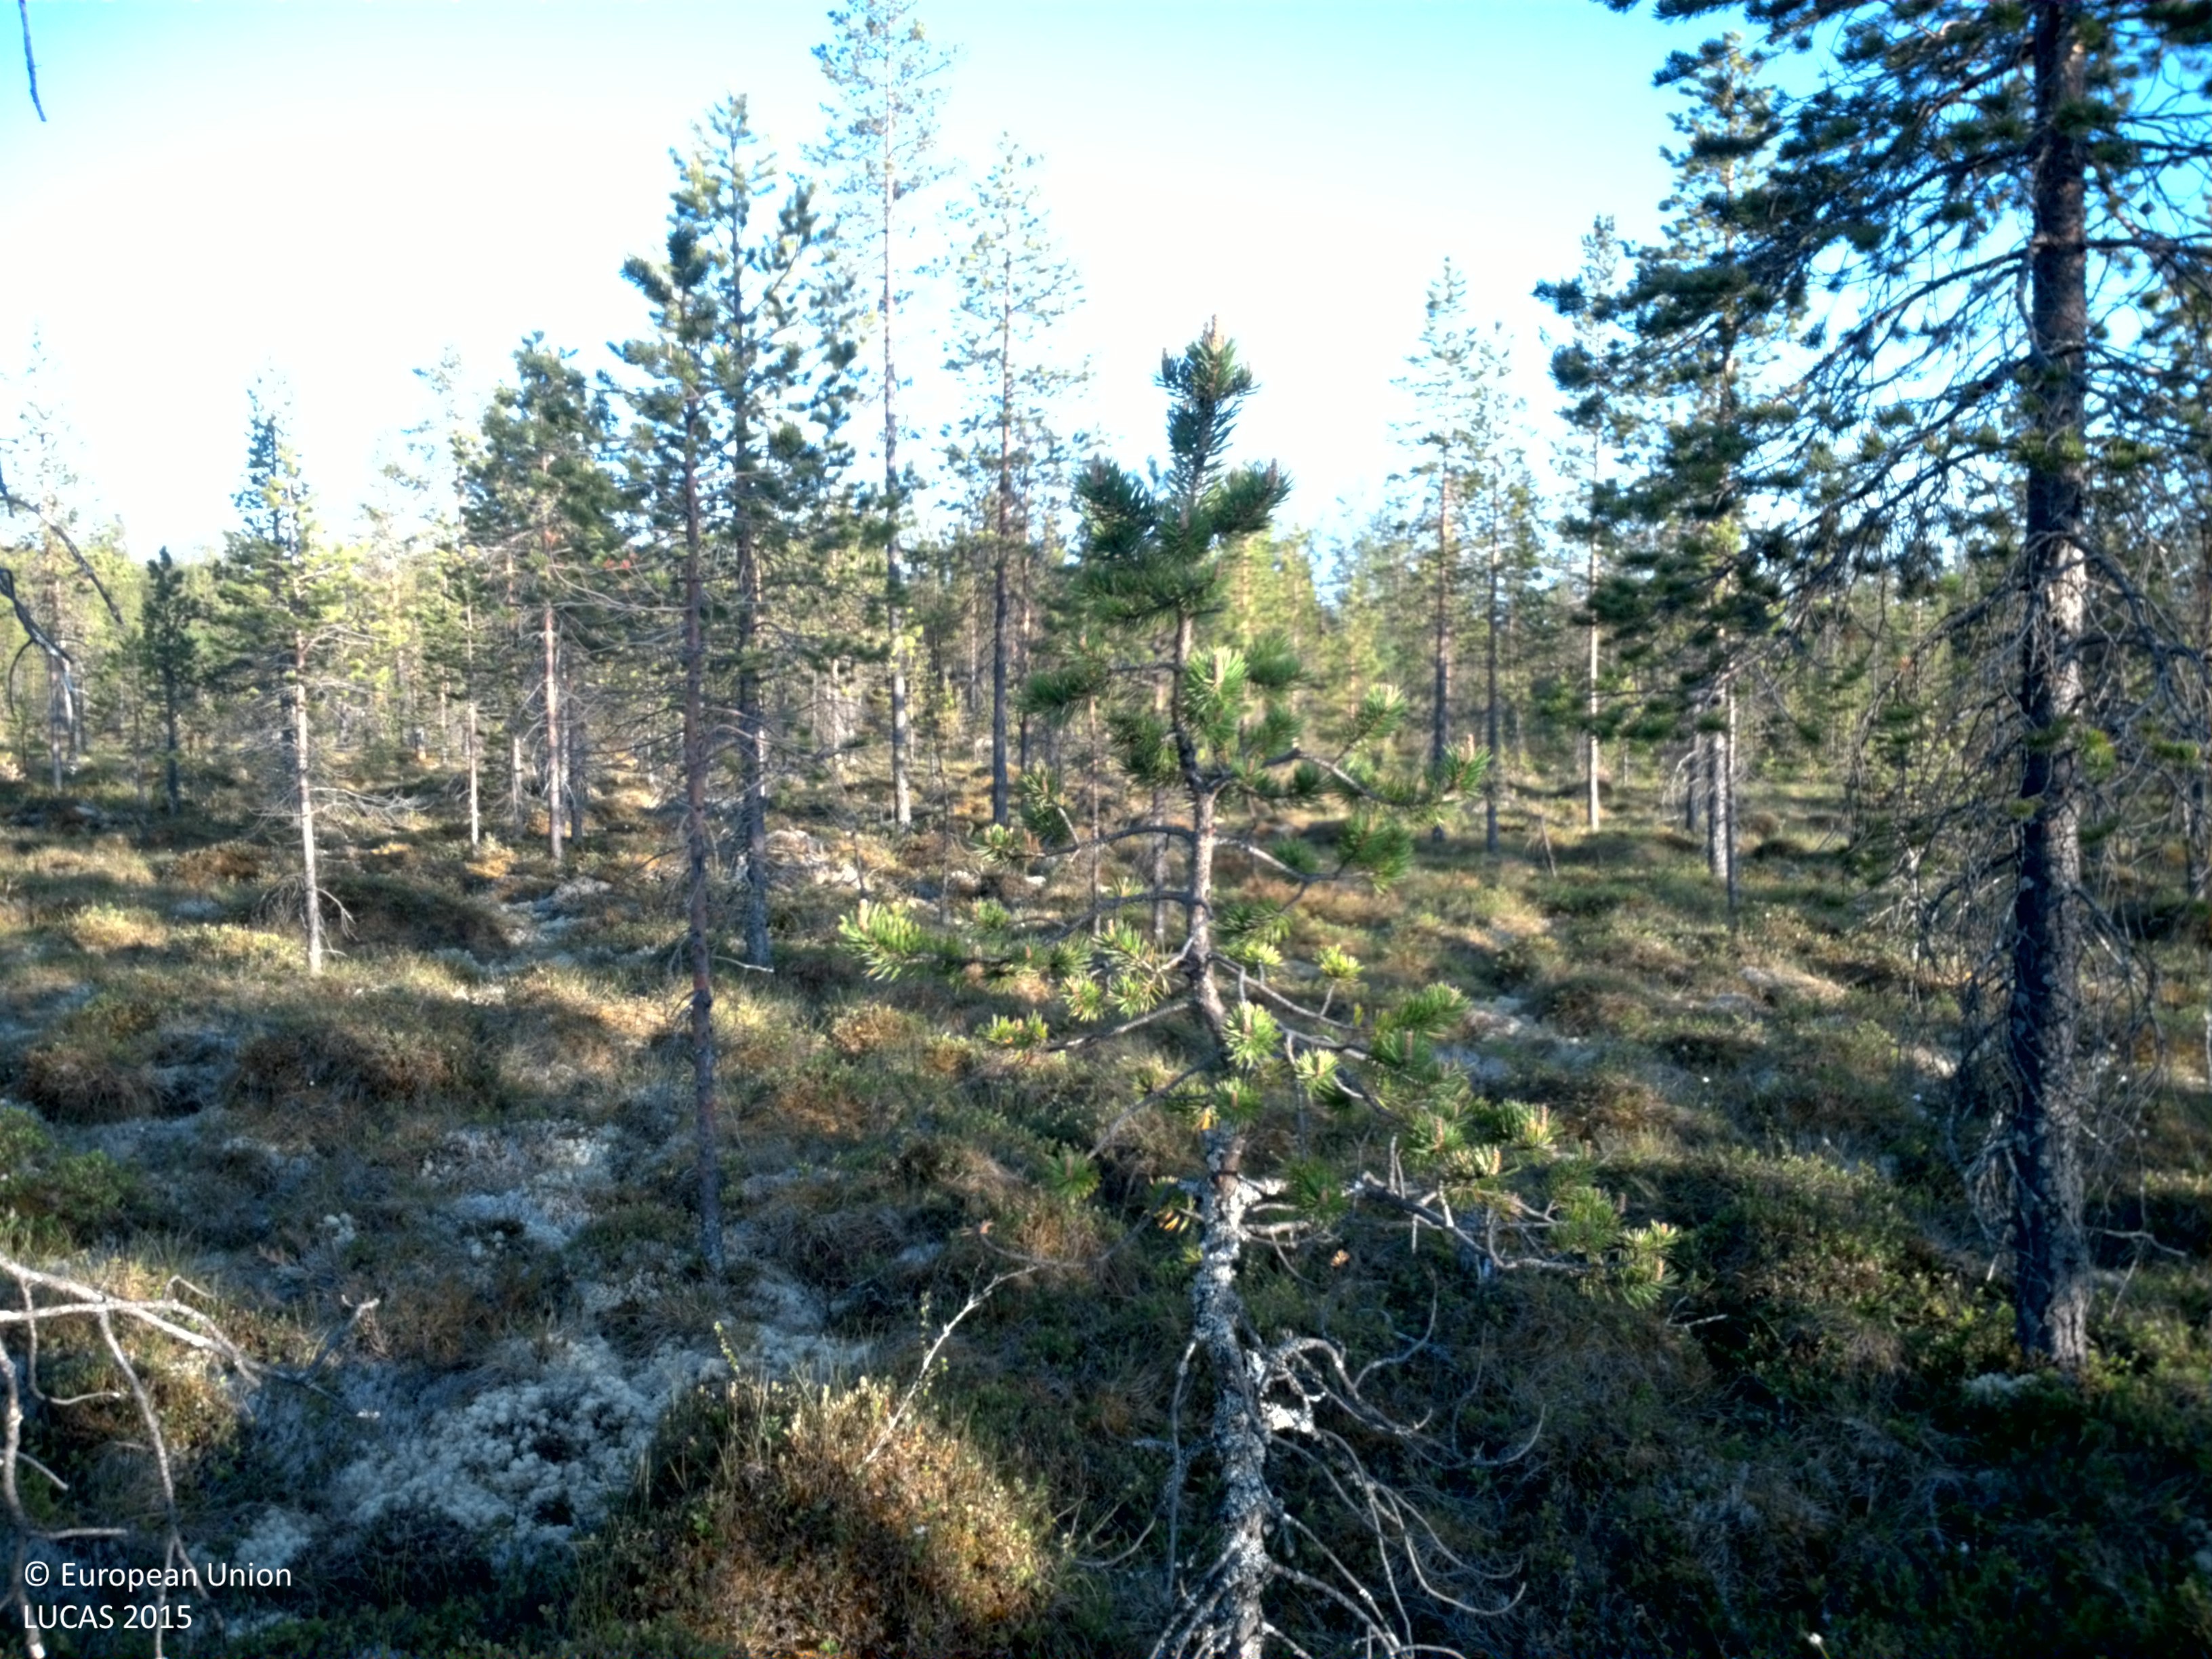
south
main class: Woodland
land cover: Pine dominated coniferous woodland
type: boreal forest
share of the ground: 10 - 25 %
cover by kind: shrubs 60 %, coniferous forest trees 25 %, lichens and mosses 15 %
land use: Forestry
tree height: > 5 m
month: June
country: SE
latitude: 61.8152
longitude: 12.5517
